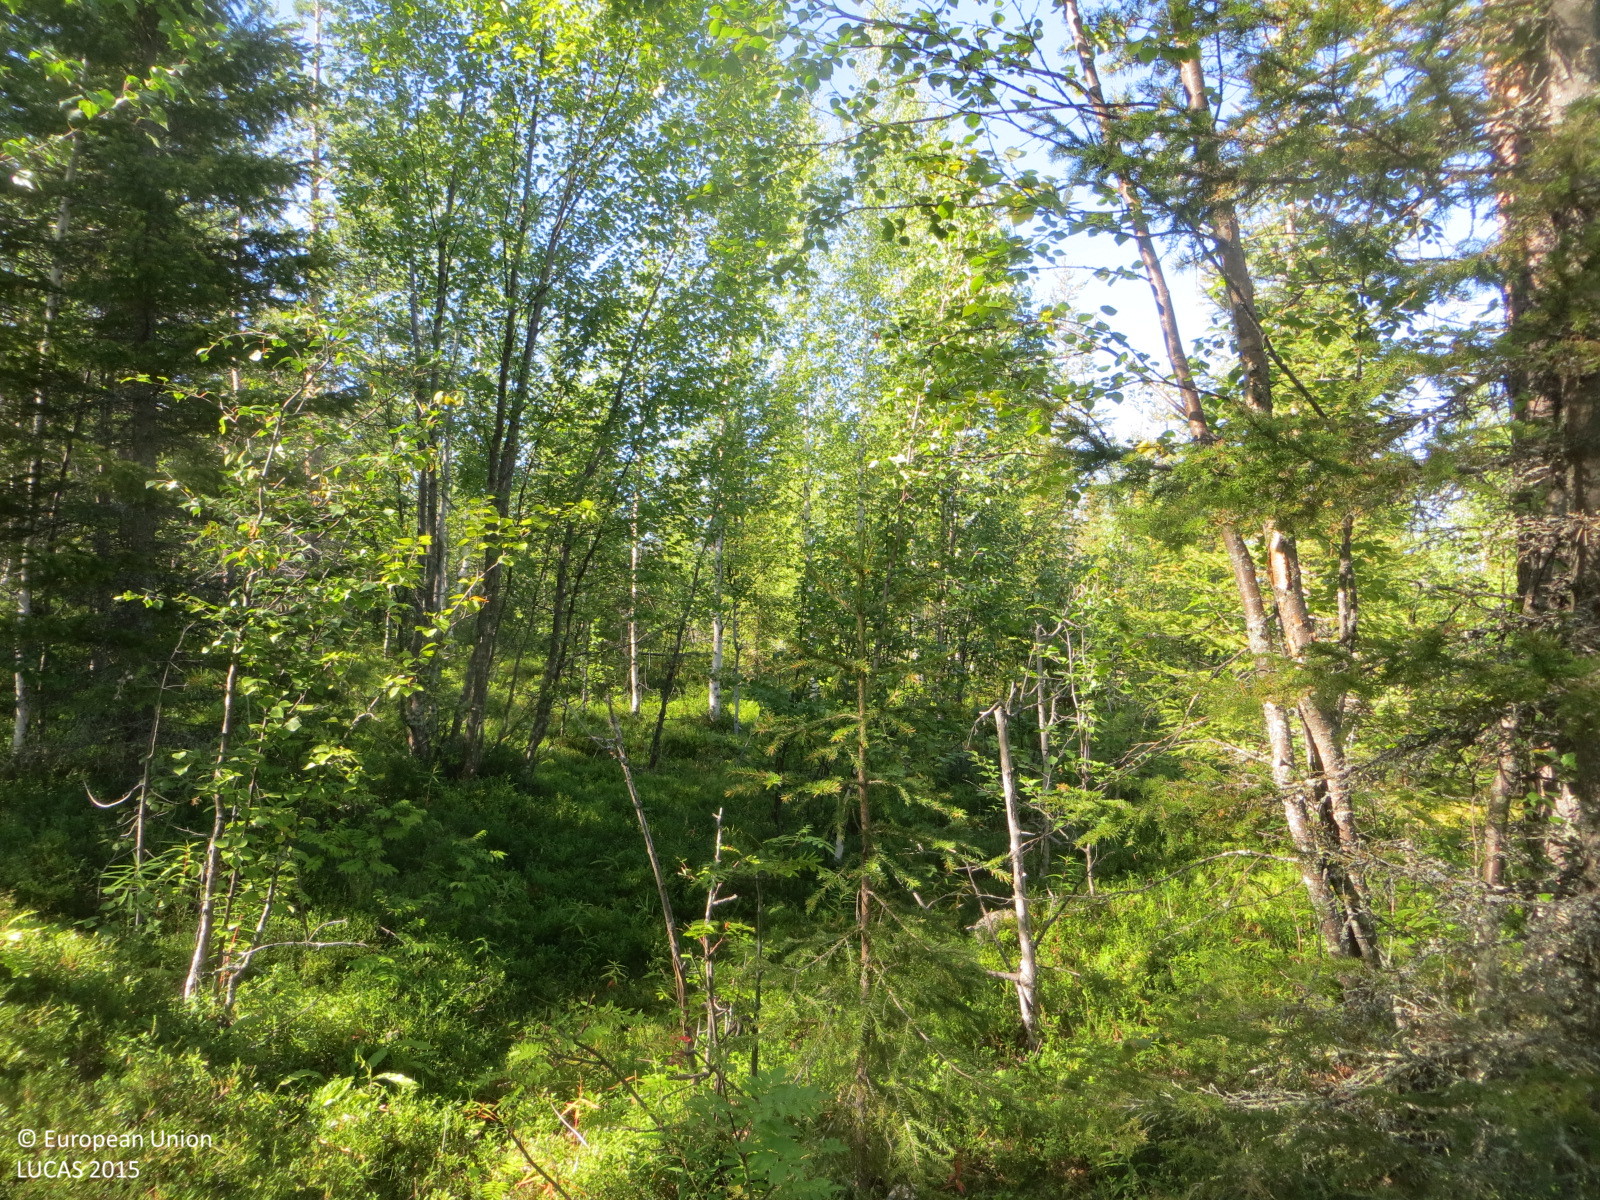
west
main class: Woodland
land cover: Pine dominated mixed woodland
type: boreal forest
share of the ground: 50 - 75 %
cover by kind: shrubs 40 %, broadleaved forest trees 35 %, coniferous forest trees 25 %
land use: Forestry
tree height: > 5 m
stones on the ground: 25 - 50 %
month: August
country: FI
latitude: 67.1941
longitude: 24.1083
